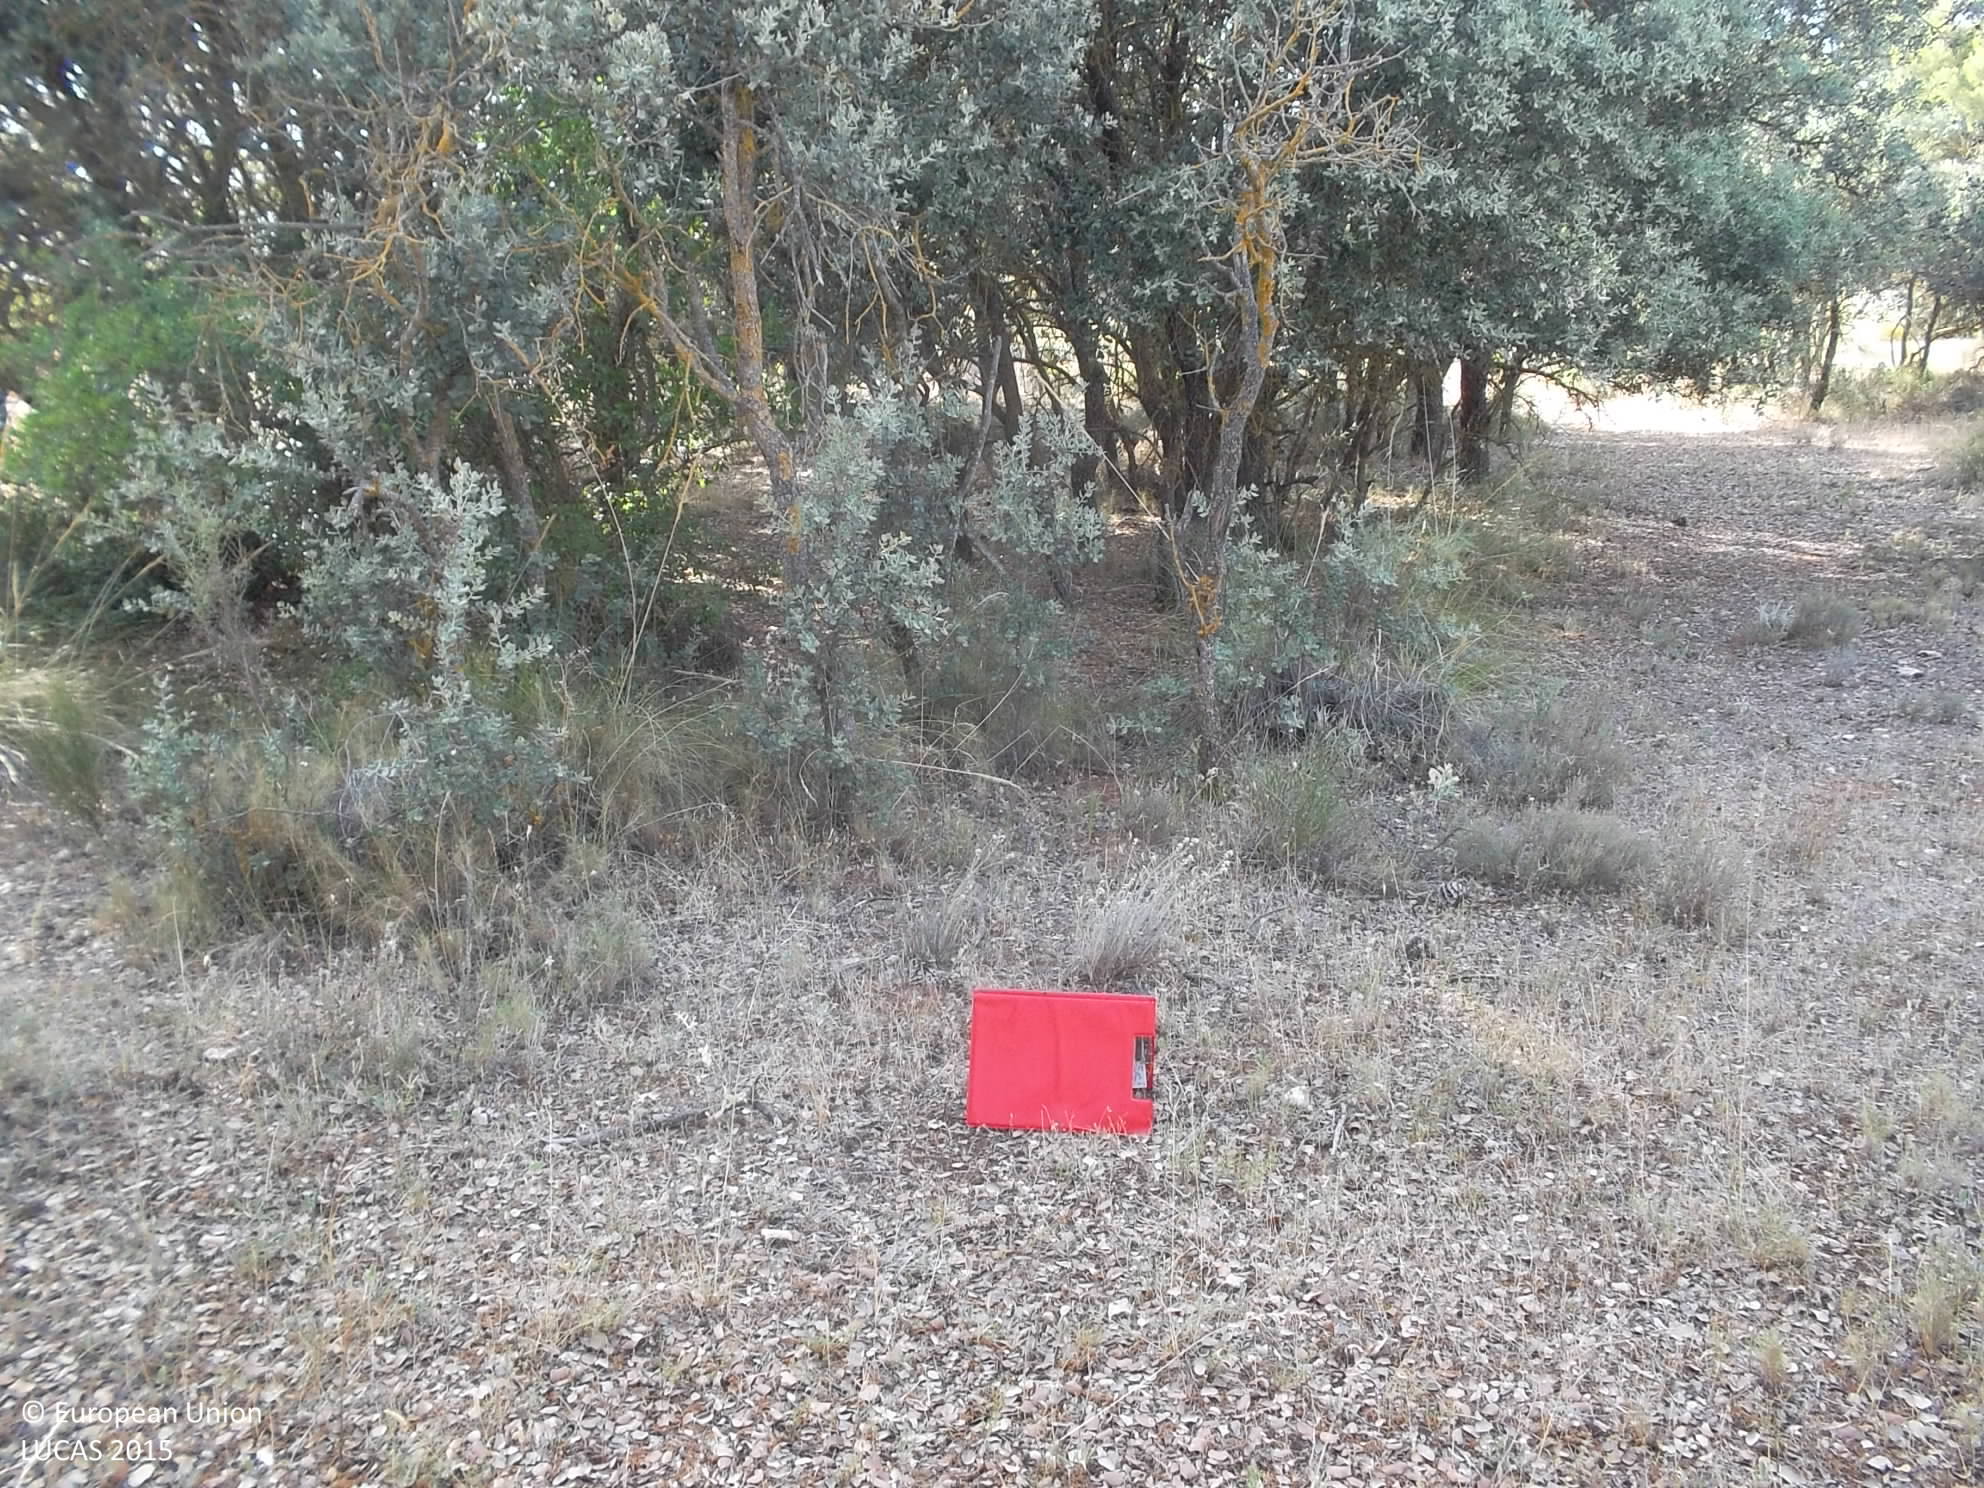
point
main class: Woodland
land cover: Broadleaved woodland
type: broadleaved evergreen forest
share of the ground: 50 - 75 %
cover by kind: broadleaved forest trees 40 %, shrubs 30 %, herbaceous plants 20 %, unconsolidated bare surface 10 %
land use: Semi-natural and natural areas not in use
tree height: > 5 m
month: June
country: ES
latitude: 37.6982
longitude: -2.8407
